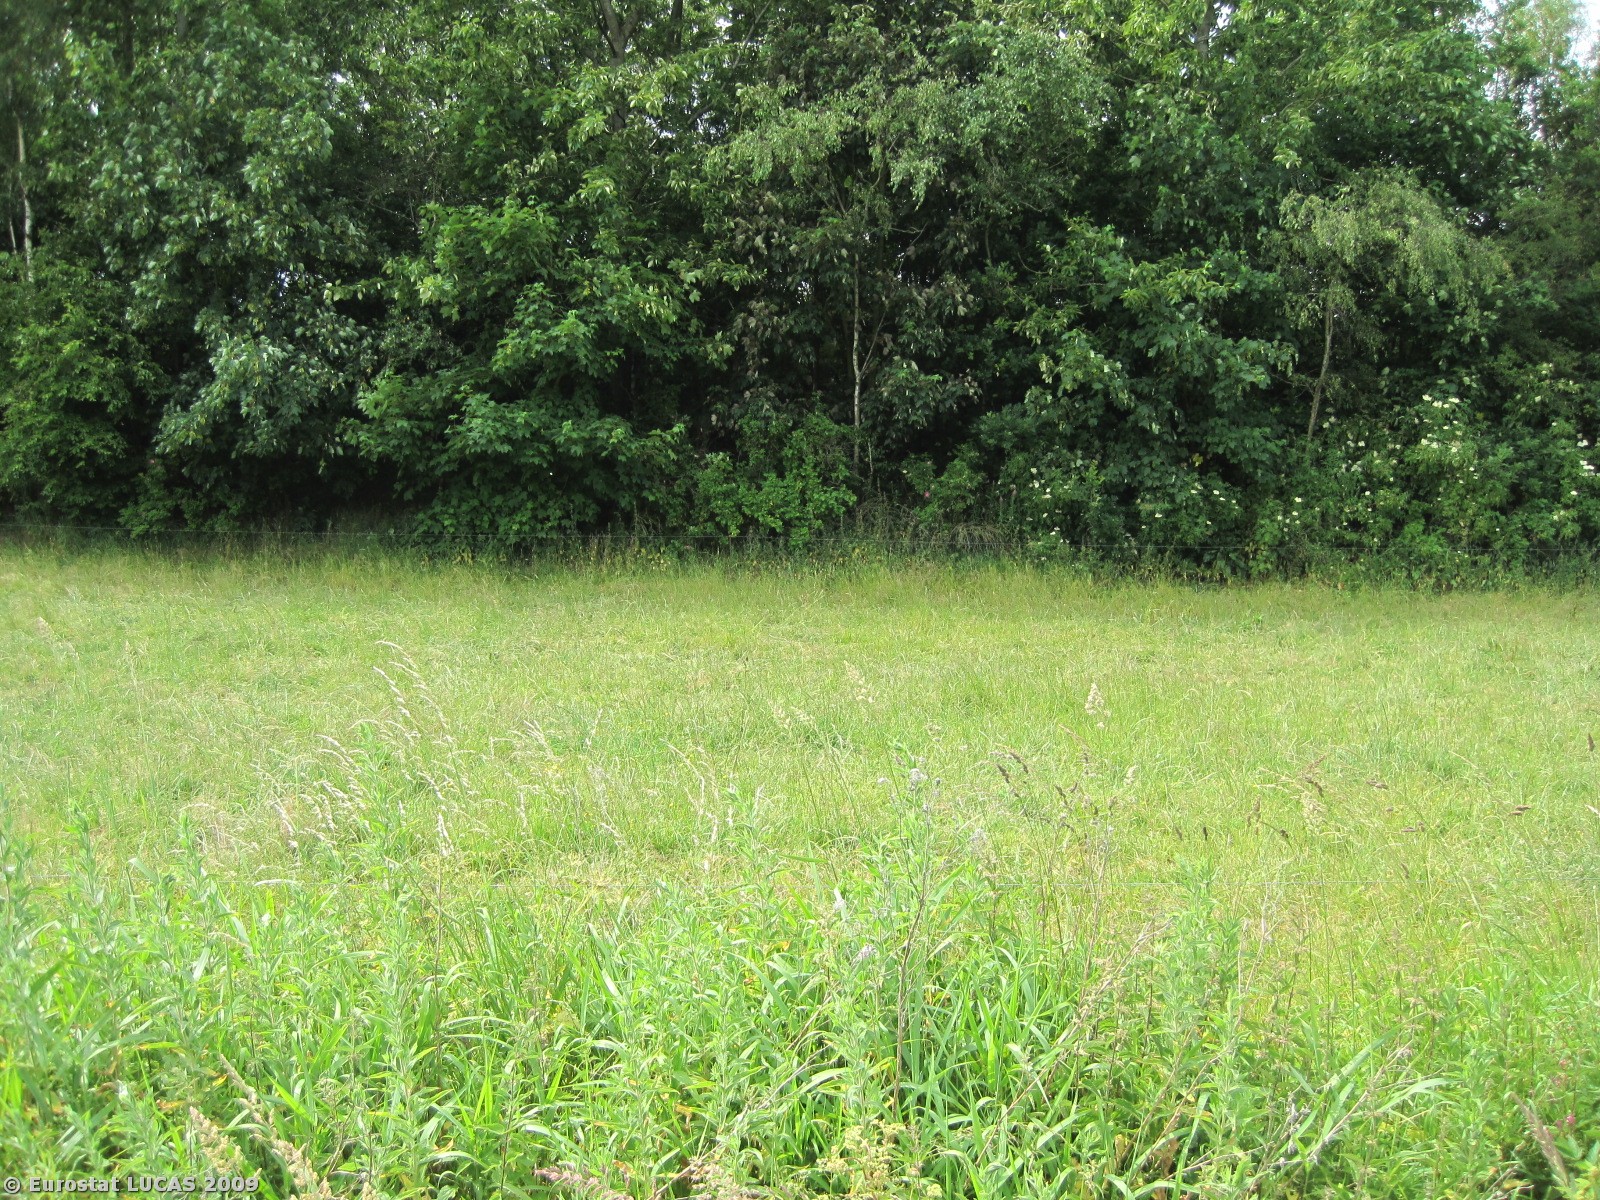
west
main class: Grassland
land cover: Grassland without tree/shrub cover
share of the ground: > 75 %
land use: Agriculture (excluding fallow land and kitchen gardens)
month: June
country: DK
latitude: 56.5017
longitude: 8.4261
